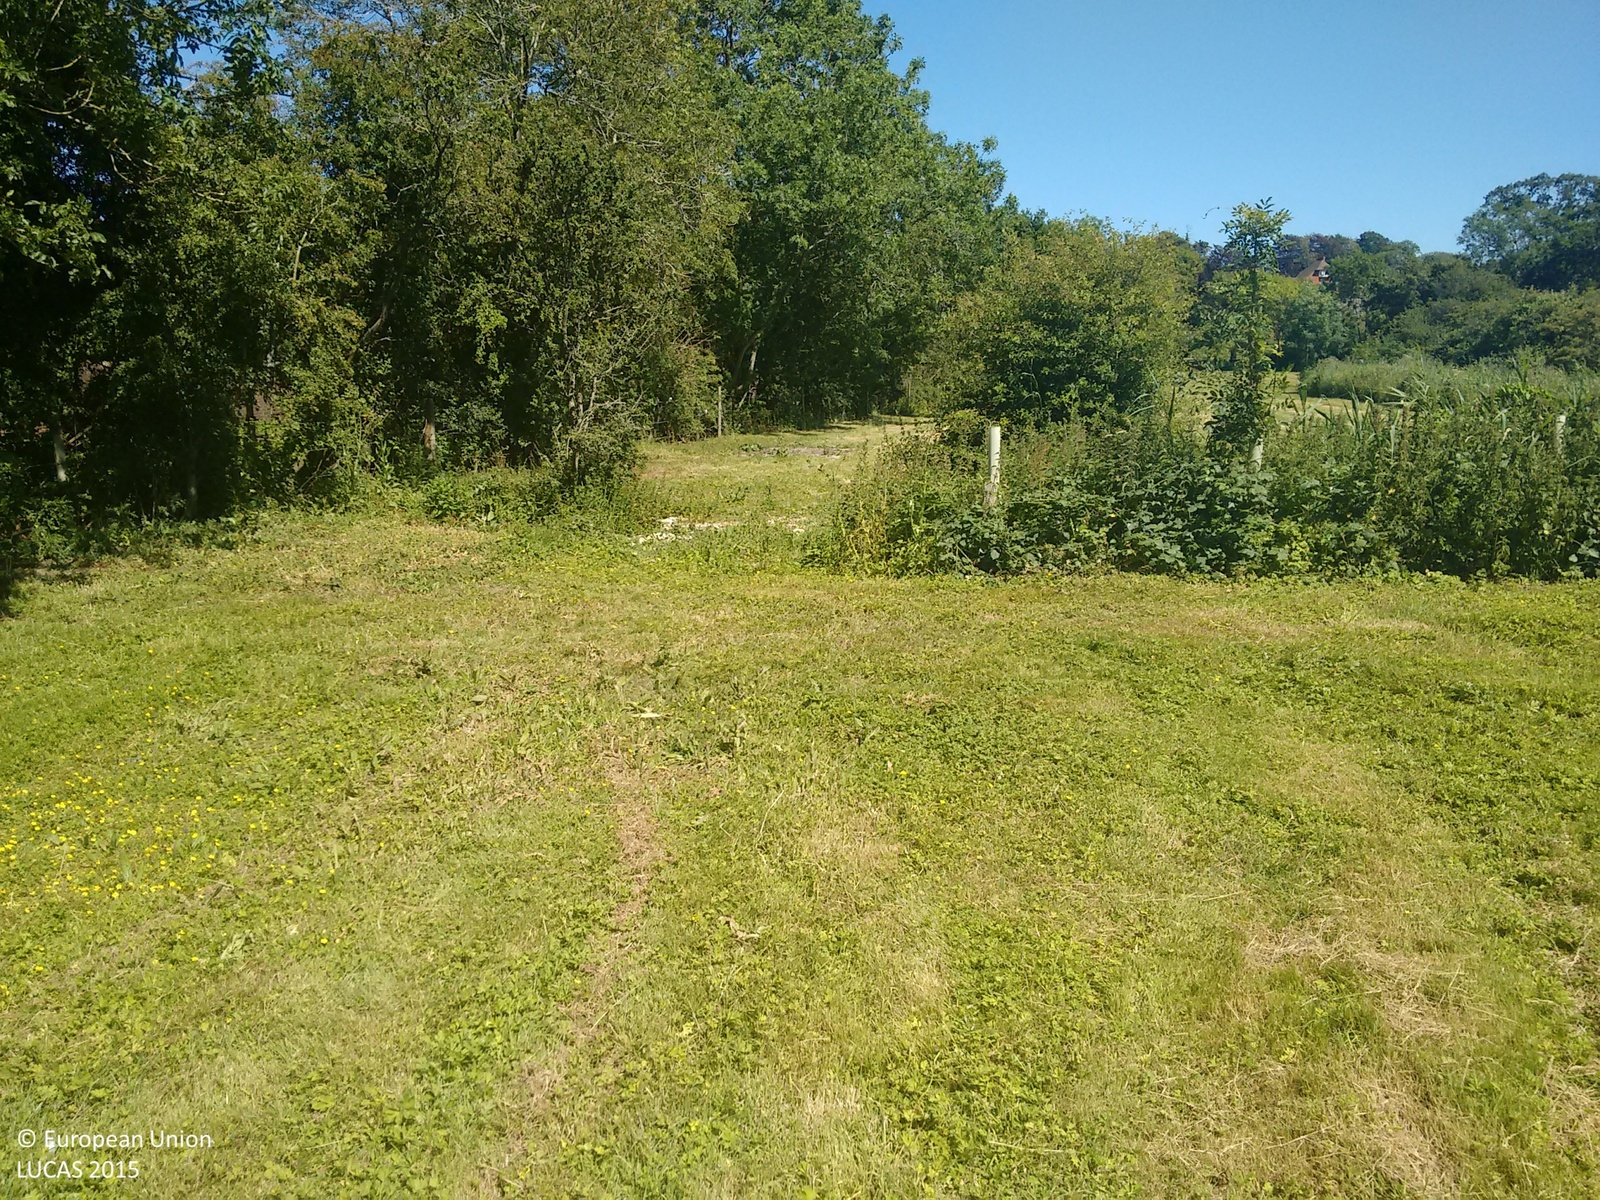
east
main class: Grassland
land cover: Grassland without tree/shrub cover
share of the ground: > 75 %
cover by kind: herbaceous plants 100 %
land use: Agriculture (excluding fallow land and kitchen gardens)
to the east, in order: Grassland without tree/shrub cover; Artificial constructions; Rivers and streams; Grassland without tree/shrub cover; Fences; Lines of trees; Rivers and streams; Grass margins; Paved roads, cycling and walking lanes; Electric lines; Artificial constructions; Artificial constructions in urban areas; Grassland without tree/shrub cover; Single bushes/trees; Grassland without tree/shrub cover; Electric lines; Grassland without tree/shrub cover; Fences; Managed hedges; Grassland without tree/shrub cover; Artificial constructions in urban areas; Managed hedges; Grassland without tree/shrub cover
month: June
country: GB
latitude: 50.8554
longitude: -0.5365
